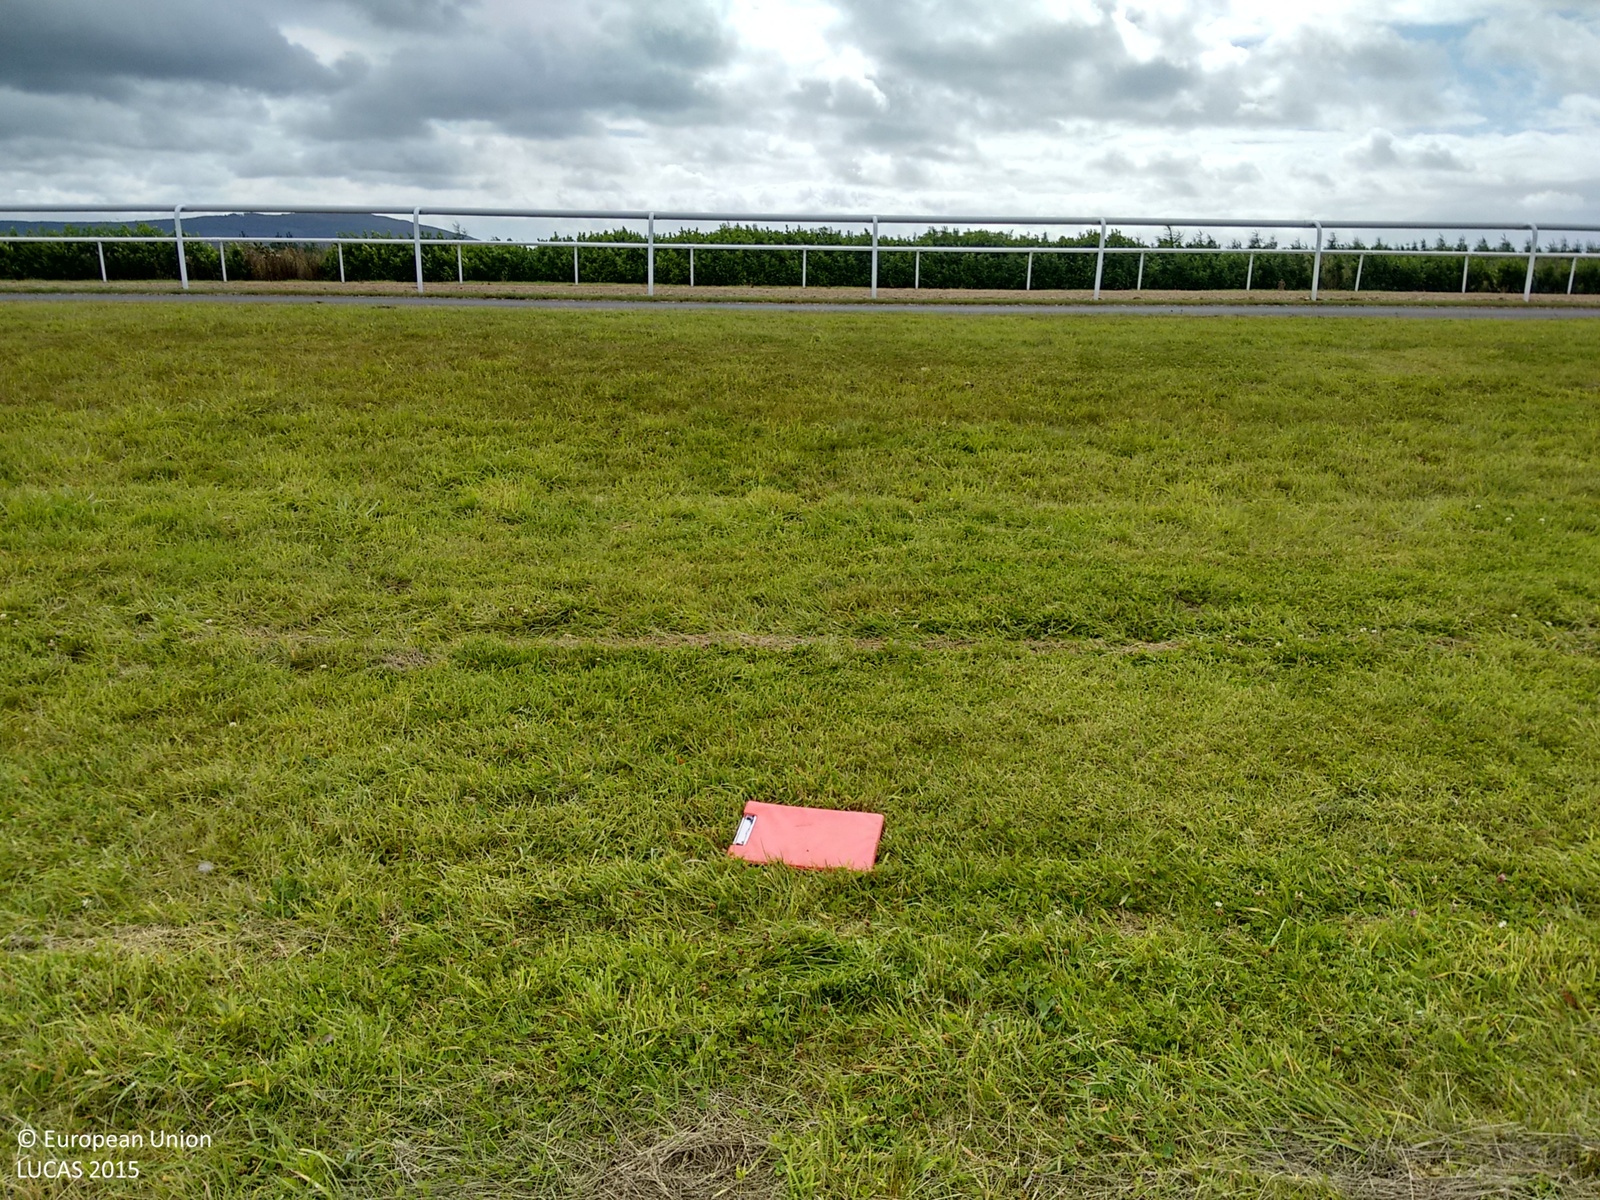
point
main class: Grassland
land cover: Grassland without tree/shrub cover
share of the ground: > 75 %
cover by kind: herbaceous plants 100 %
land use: Amenities, museums, leisure
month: August
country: IE
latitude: 54.0213
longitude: -6.3776
